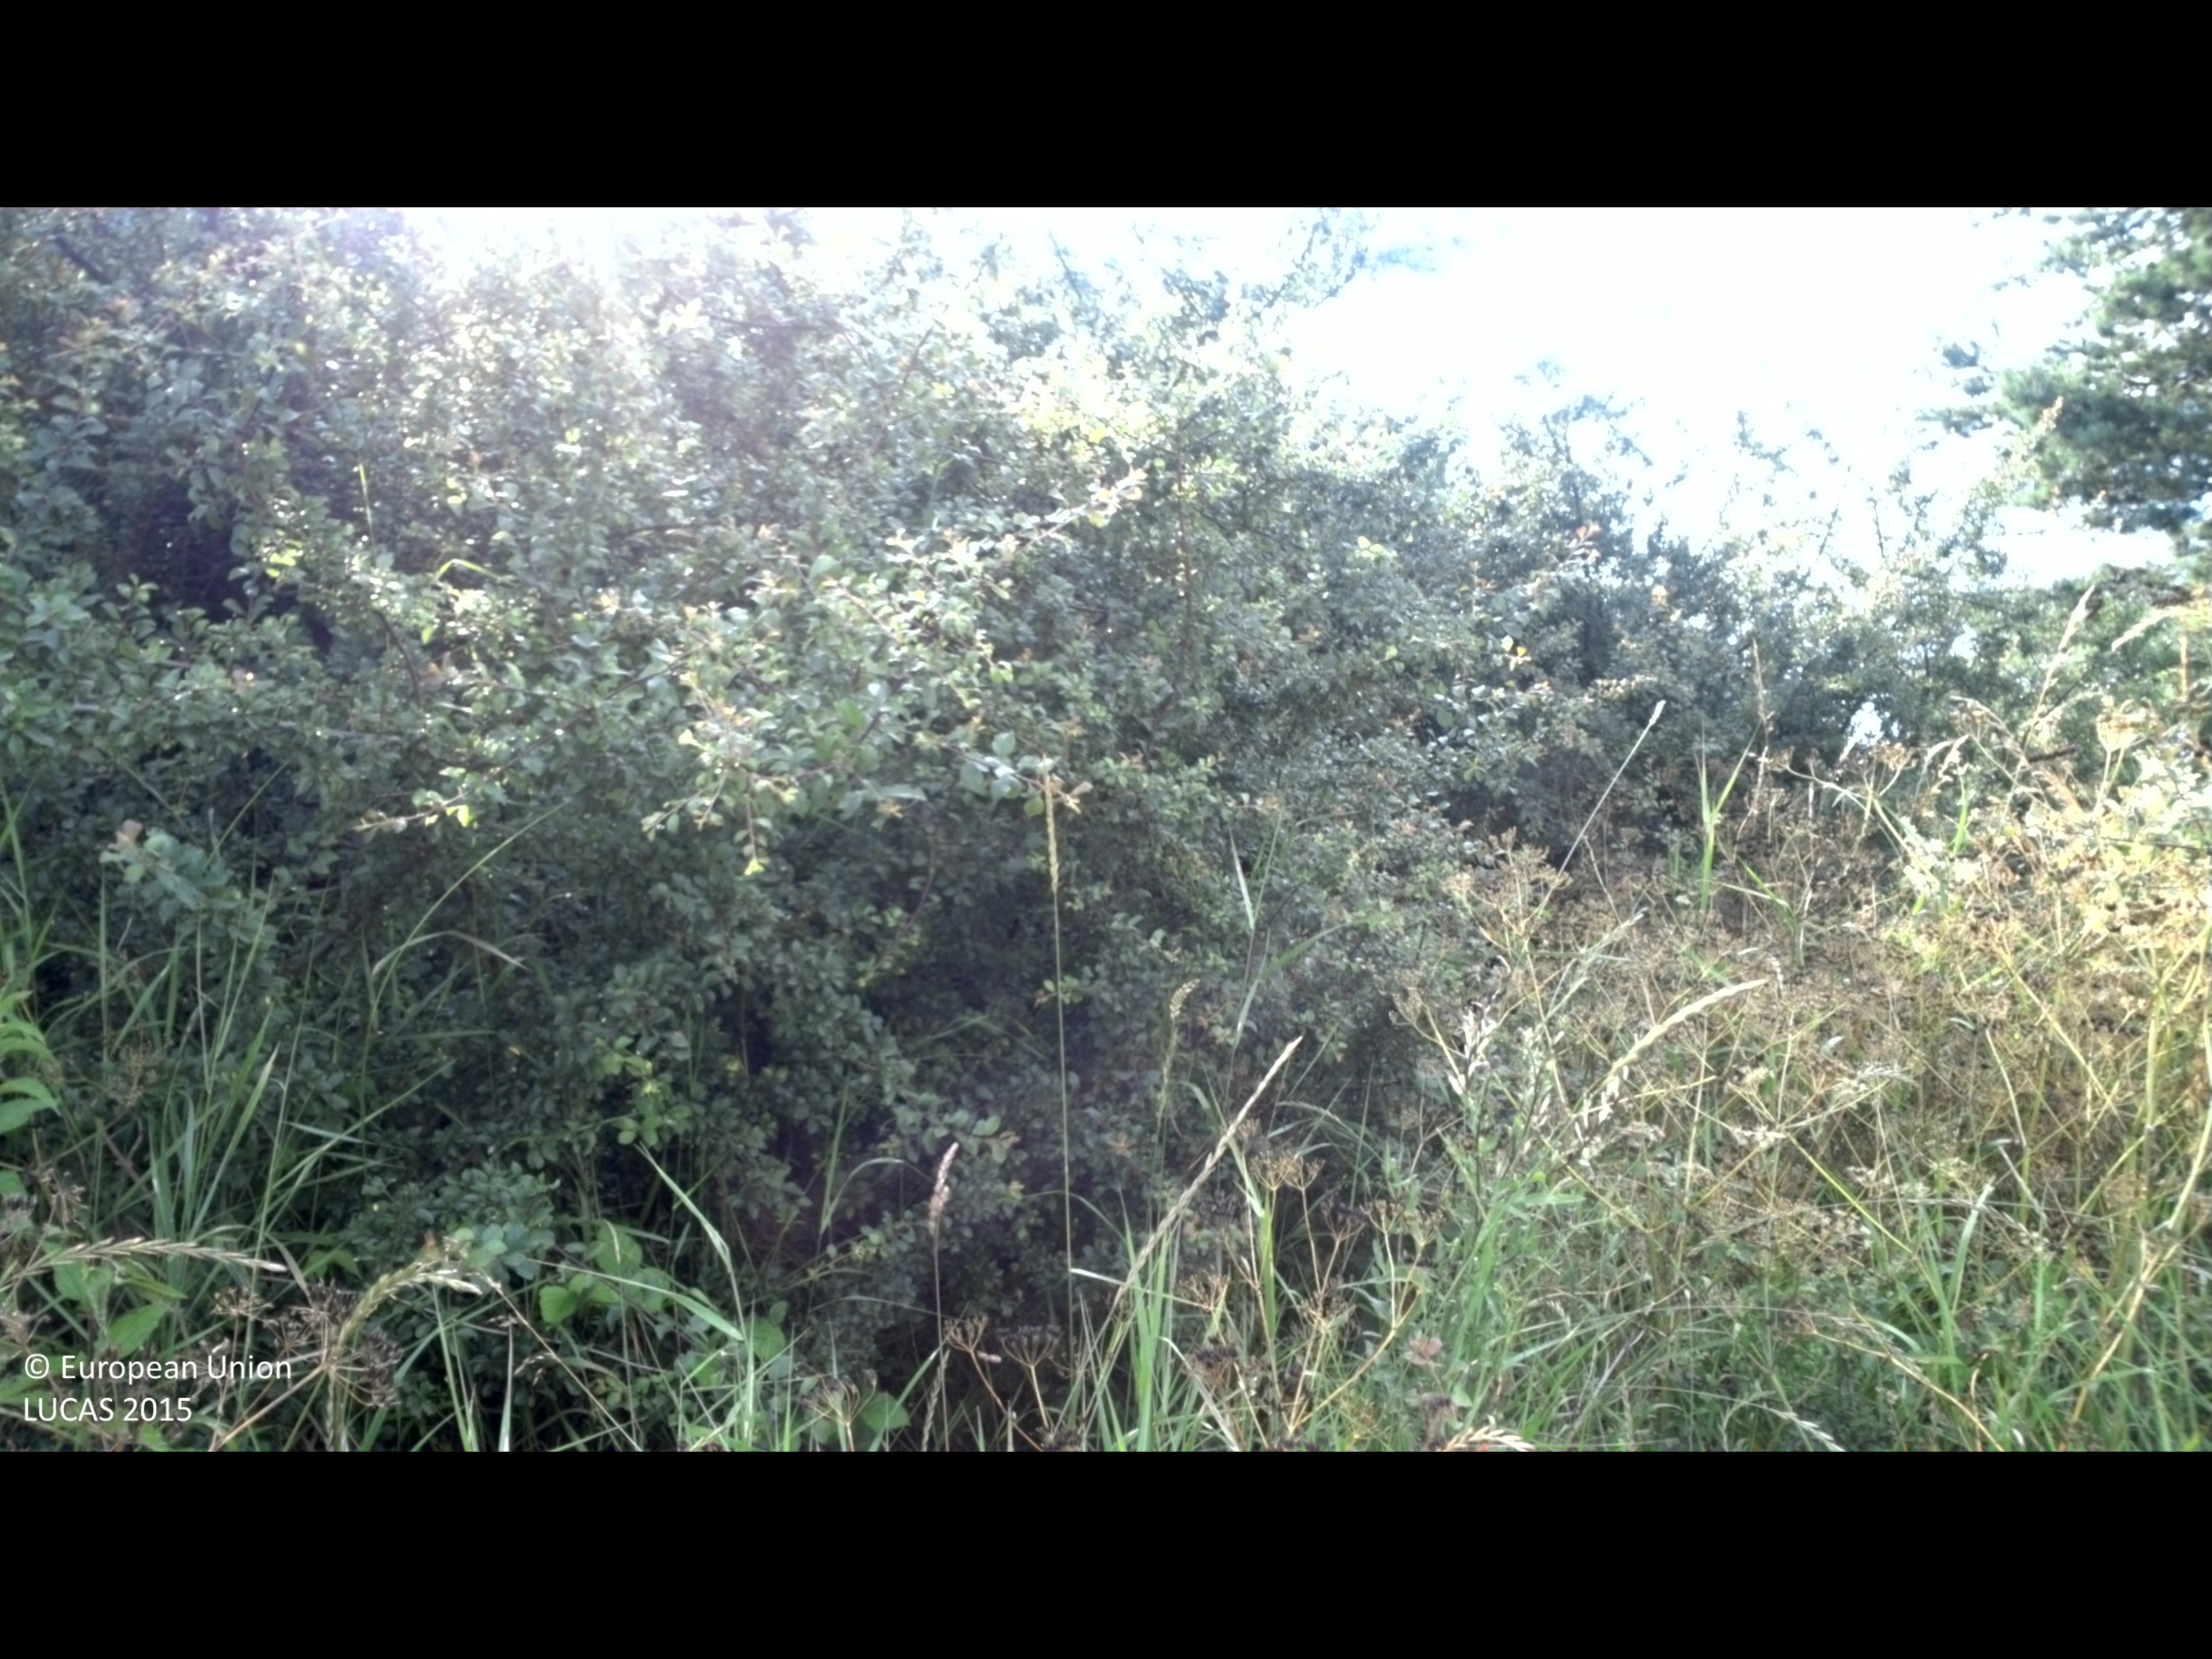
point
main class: Shrubland
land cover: Shrubland without tree cover
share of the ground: > 75 %
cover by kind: shrubs 80 %, herbaceous plants 20 %
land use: Semi-natural and natural areas not in use
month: July
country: SE
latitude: 56.5515
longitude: 16.3944
